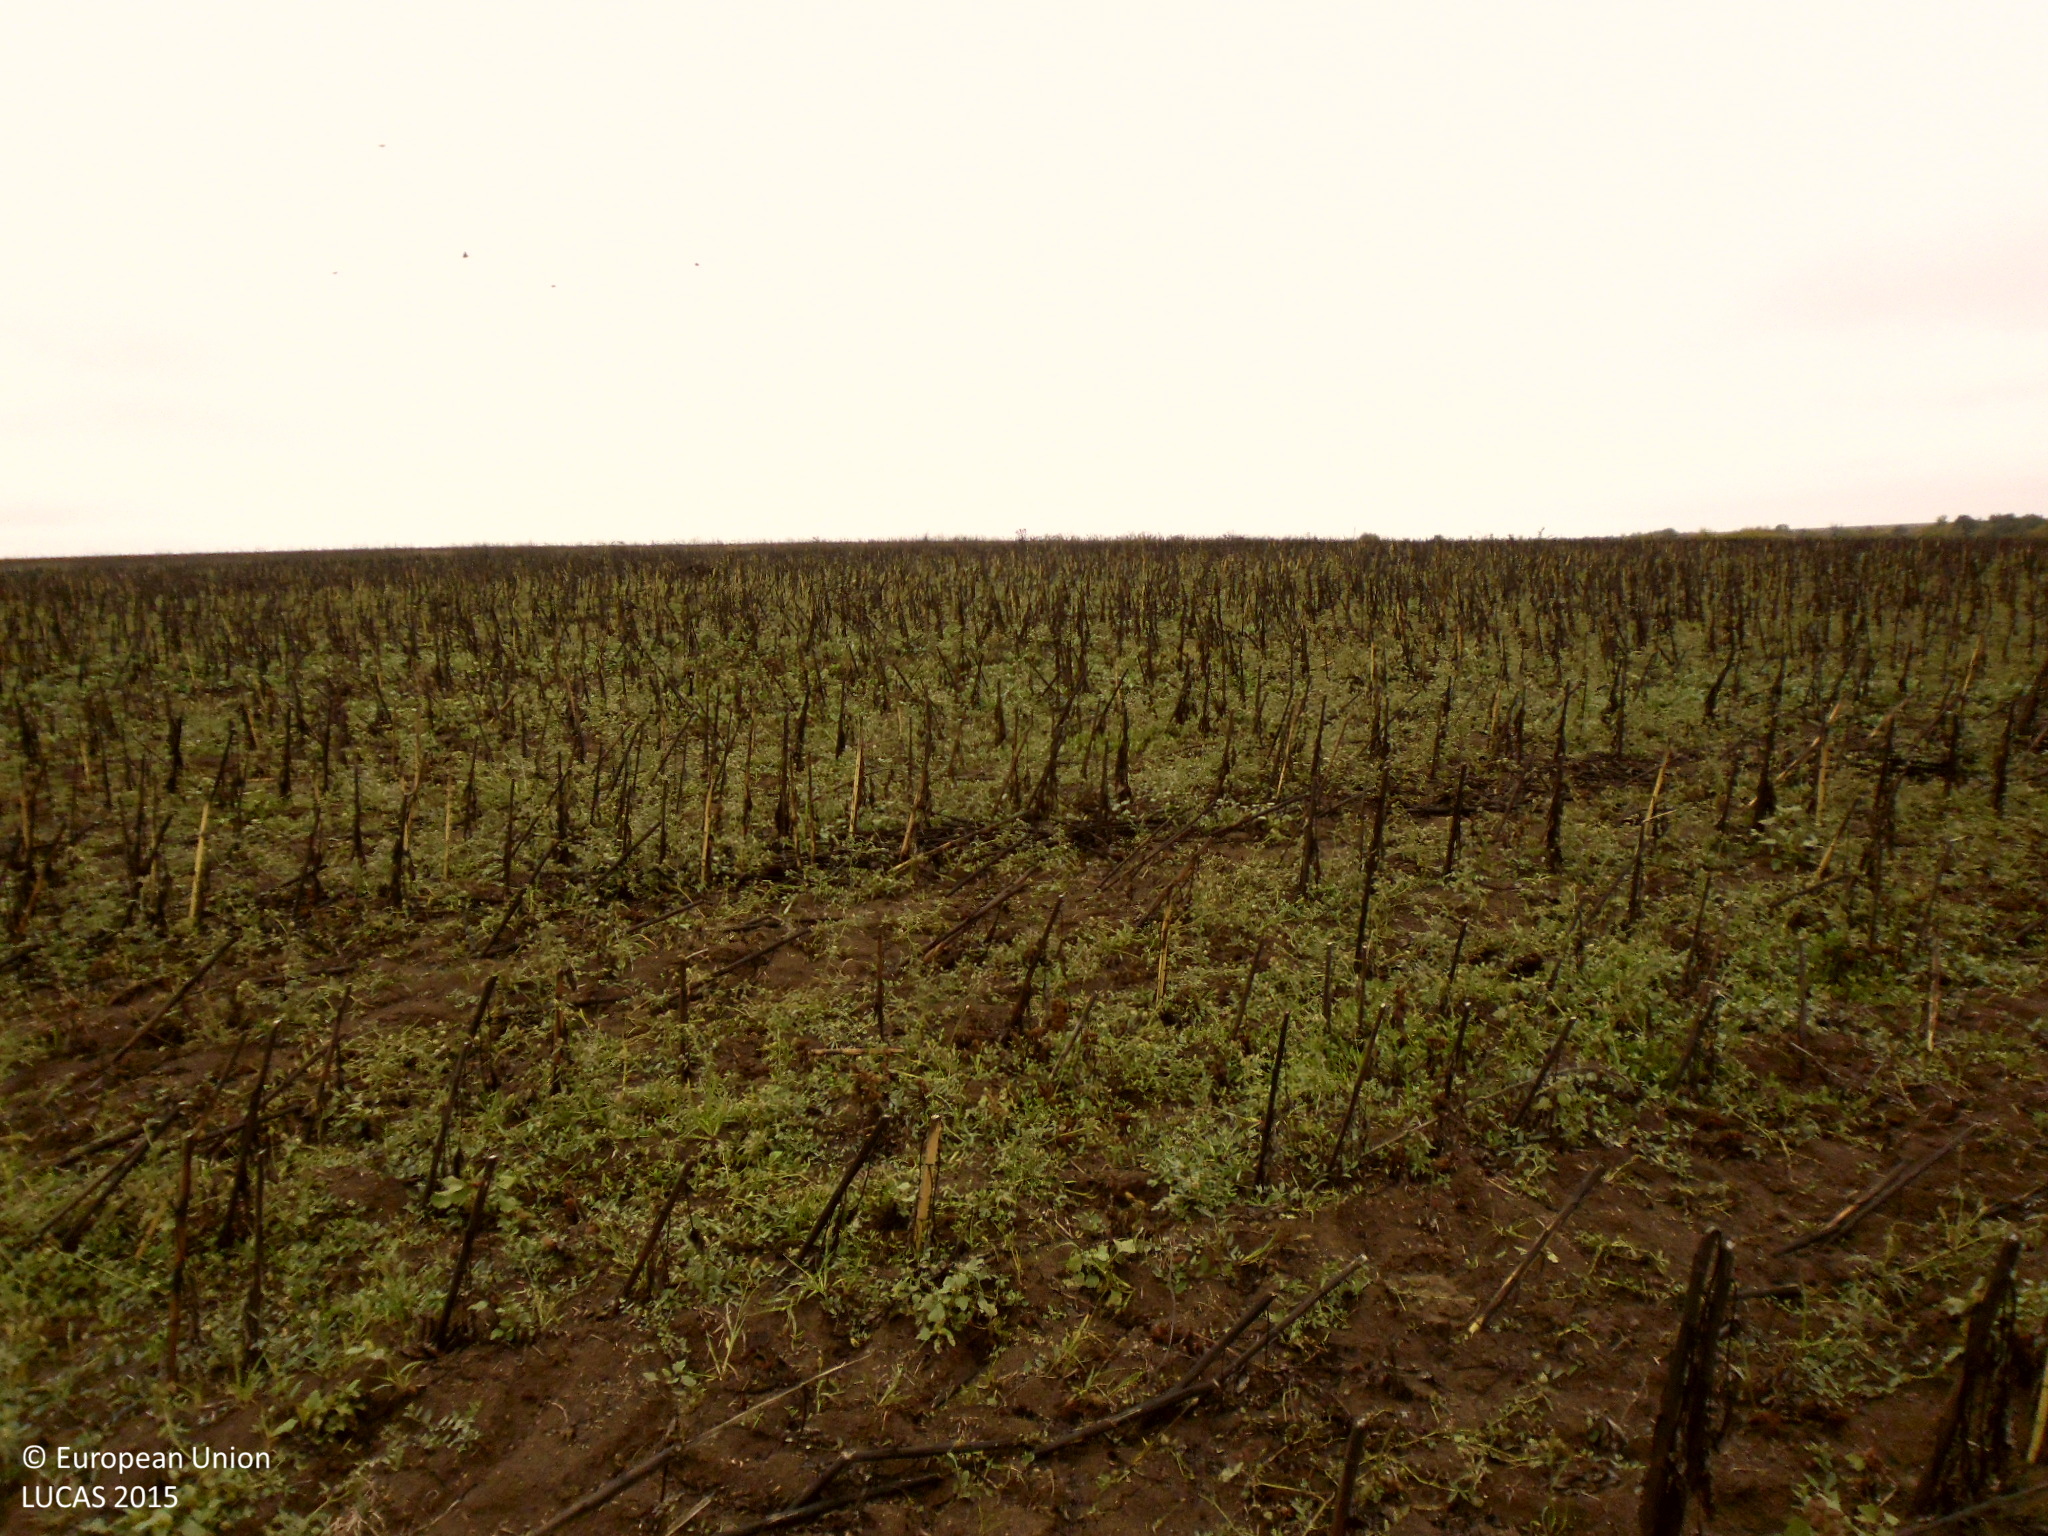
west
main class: Cropland
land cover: Sunflower
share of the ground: 10 - 25 %
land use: Agriculture (excluding fallow land and kitchen gardens)
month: October
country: BG
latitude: 43.6788
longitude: 22.8249
